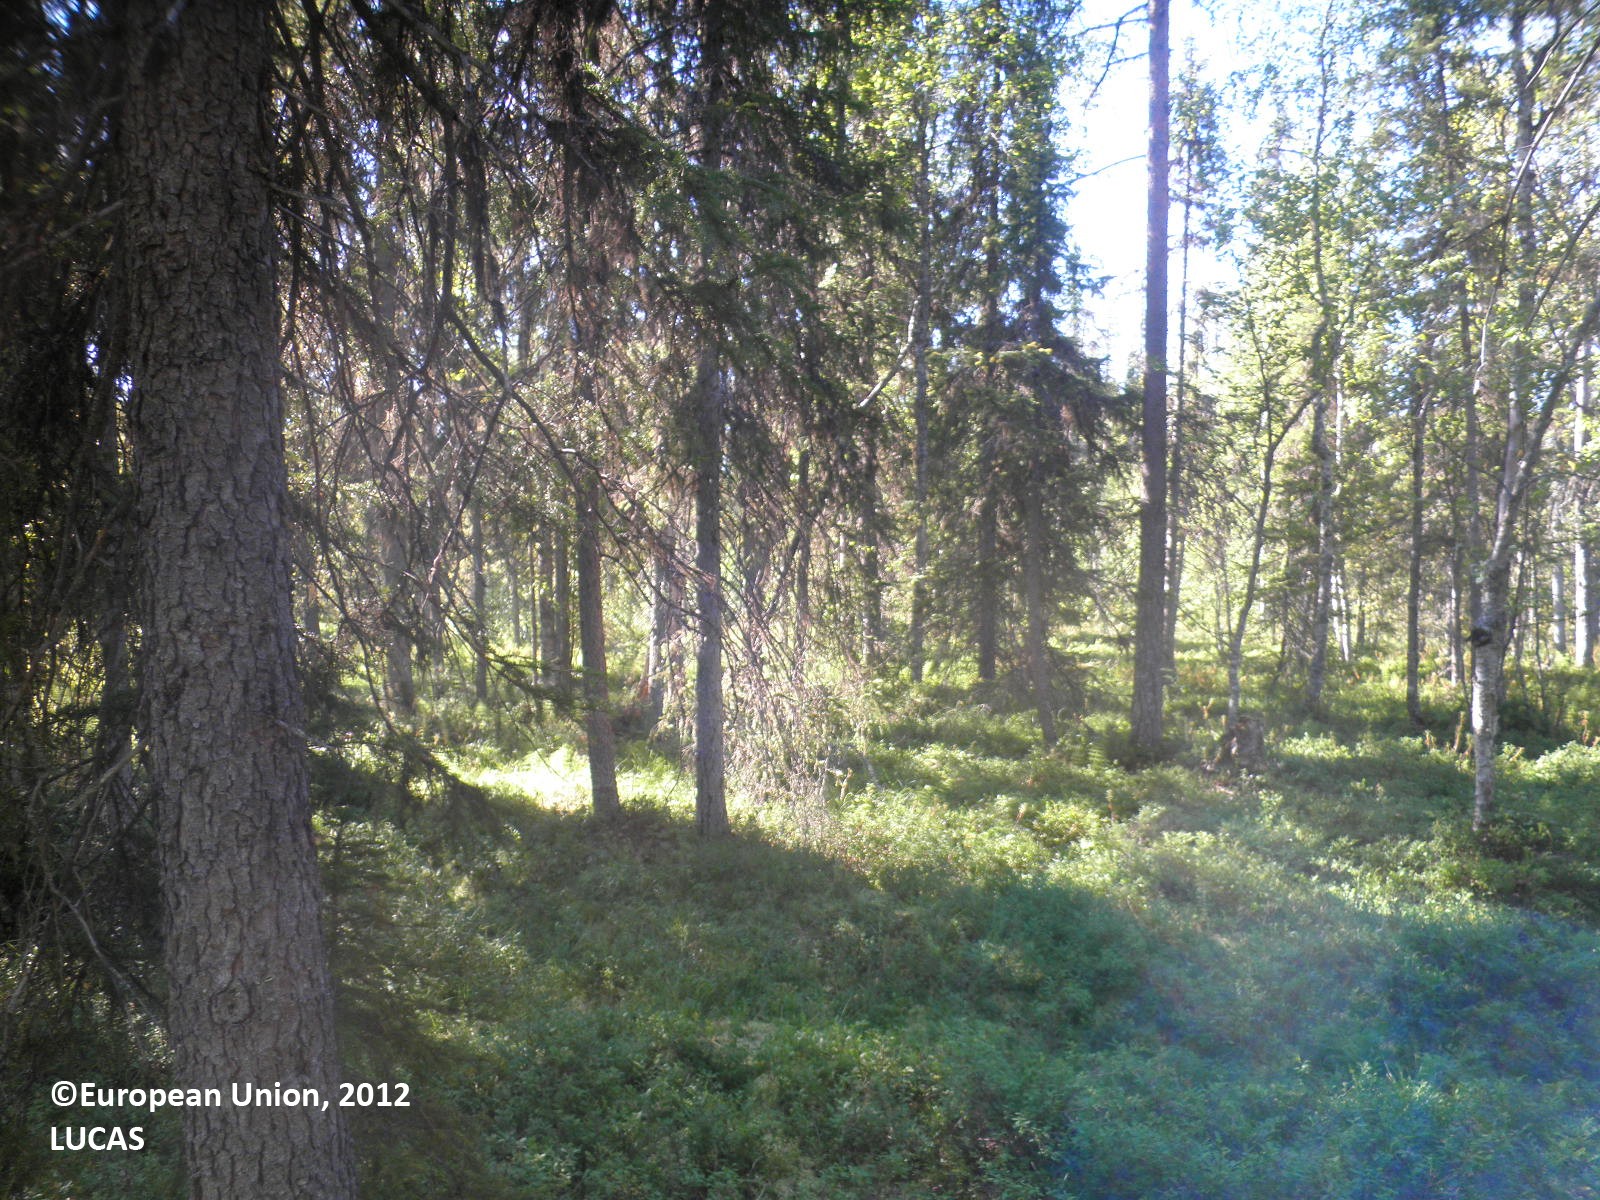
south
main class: Woodland
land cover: Spruce dominated mixed woodland
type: boreal forest
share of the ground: 50 - 75 %
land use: Forestry
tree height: > 5 m
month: August
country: FI
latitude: 67.4881
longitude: 25.8548
